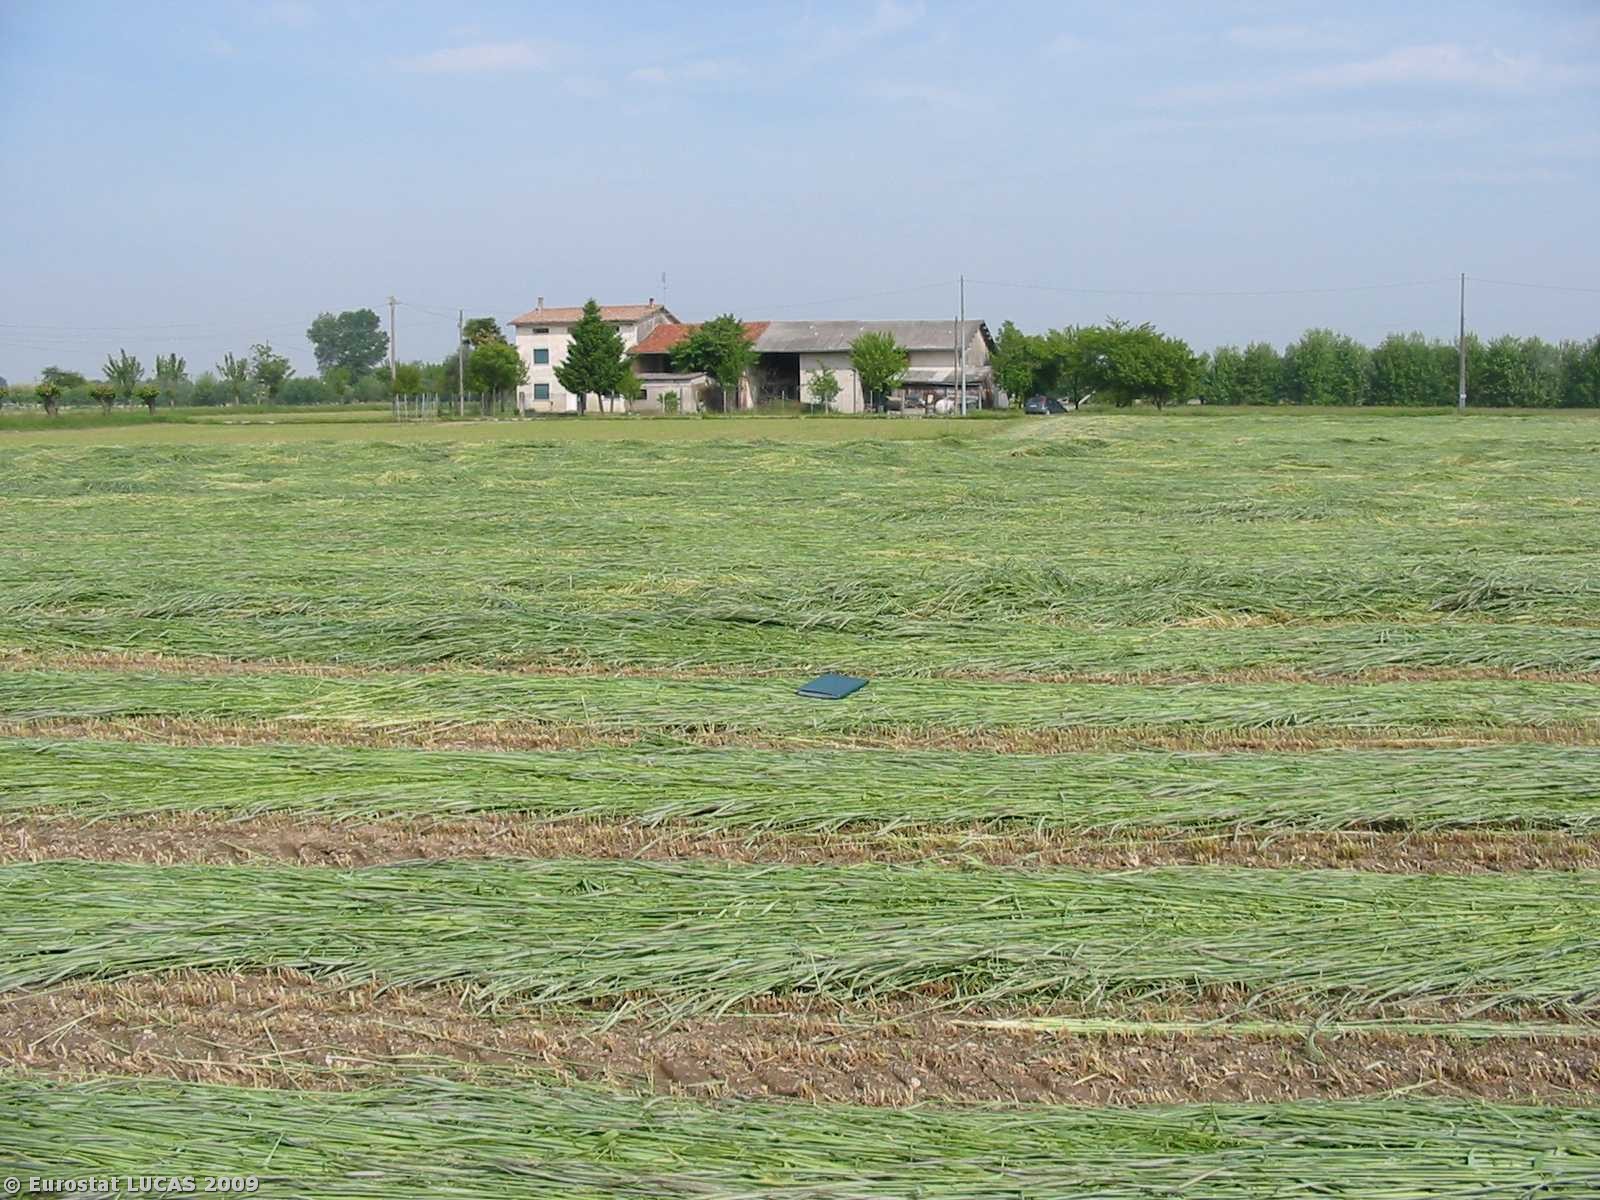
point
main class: Cropland
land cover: Rye
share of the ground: < 10 %
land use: Agriculture (excluding fallow land and kitchen gardens)
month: May
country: IT
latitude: 45.5083
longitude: 11.7251
